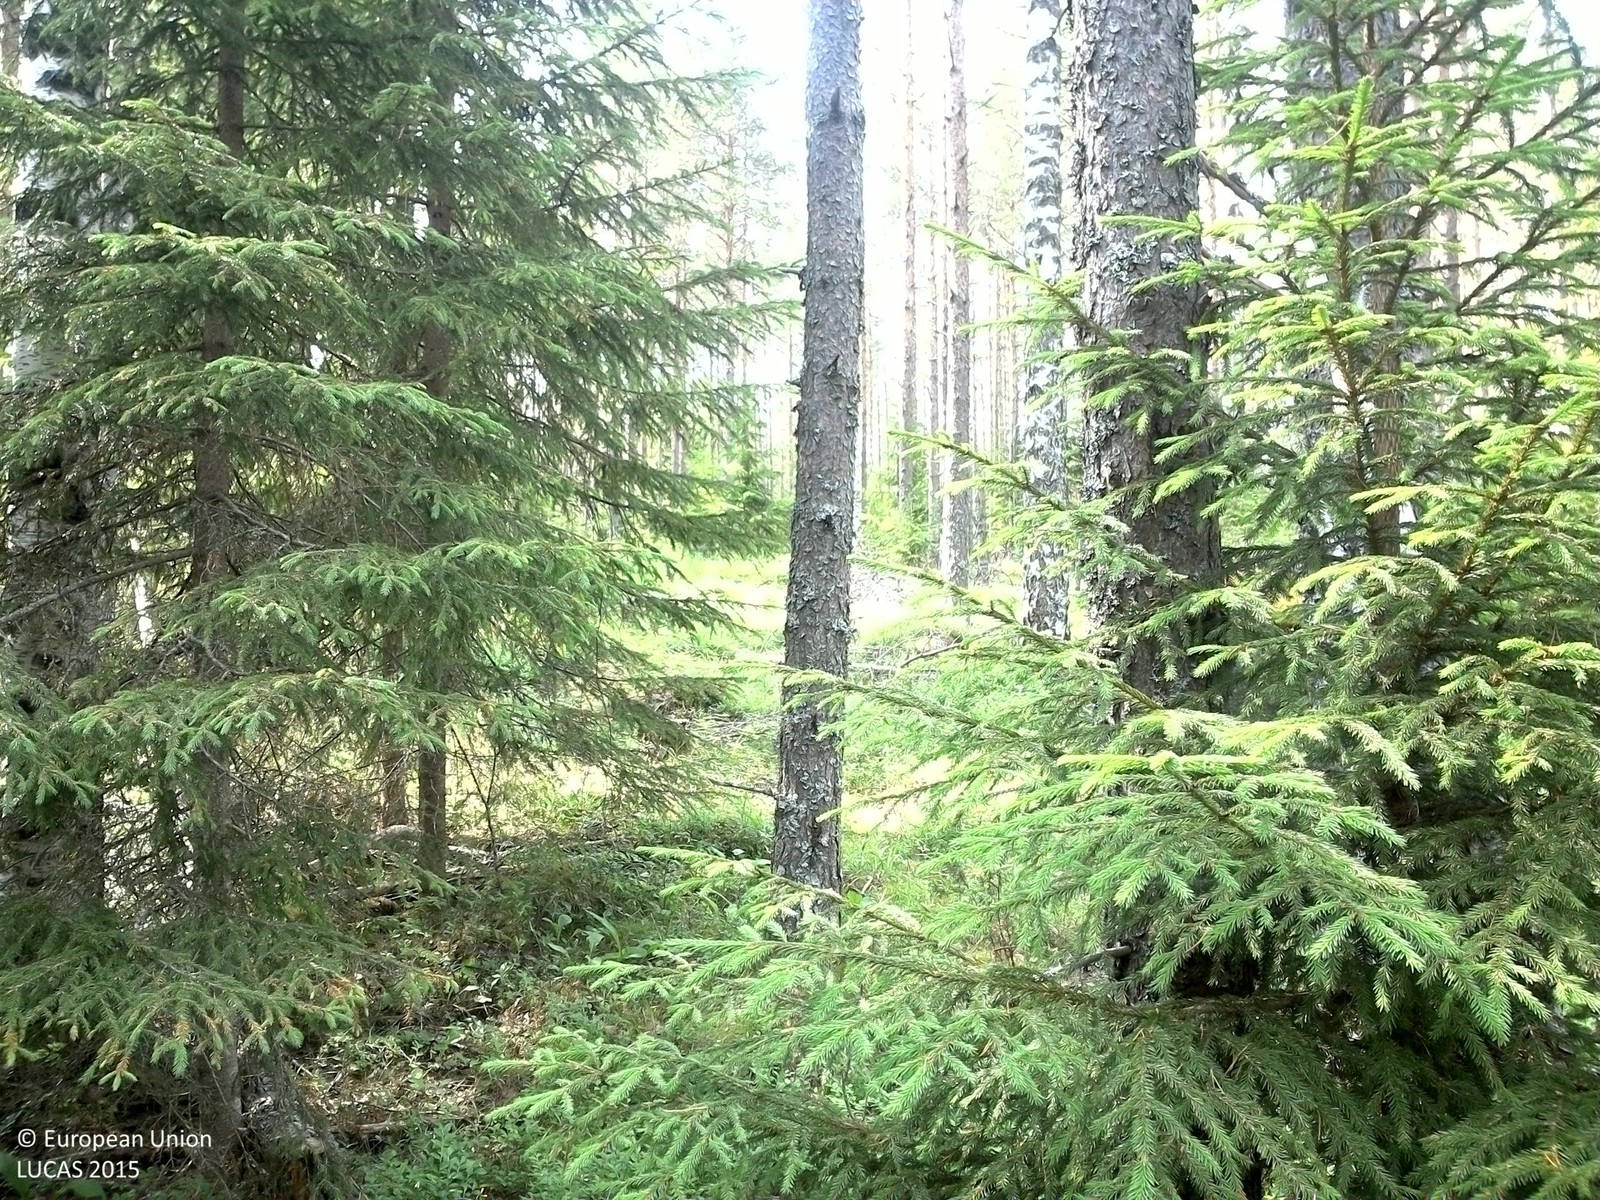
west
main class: Woodland
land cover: Pine dominated coniferous woodland
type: boreal forest
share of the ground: 50 - 75 %
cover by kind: coniferous forest trees 55 %, herbaceous plants 20 %, shrubs 10 %, lichens and mosses 10 %, broadleaved forest trees 5 %
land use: Forestry
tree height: > 5 m
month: July
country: SE
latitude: 63.5043
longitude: 17.3069
